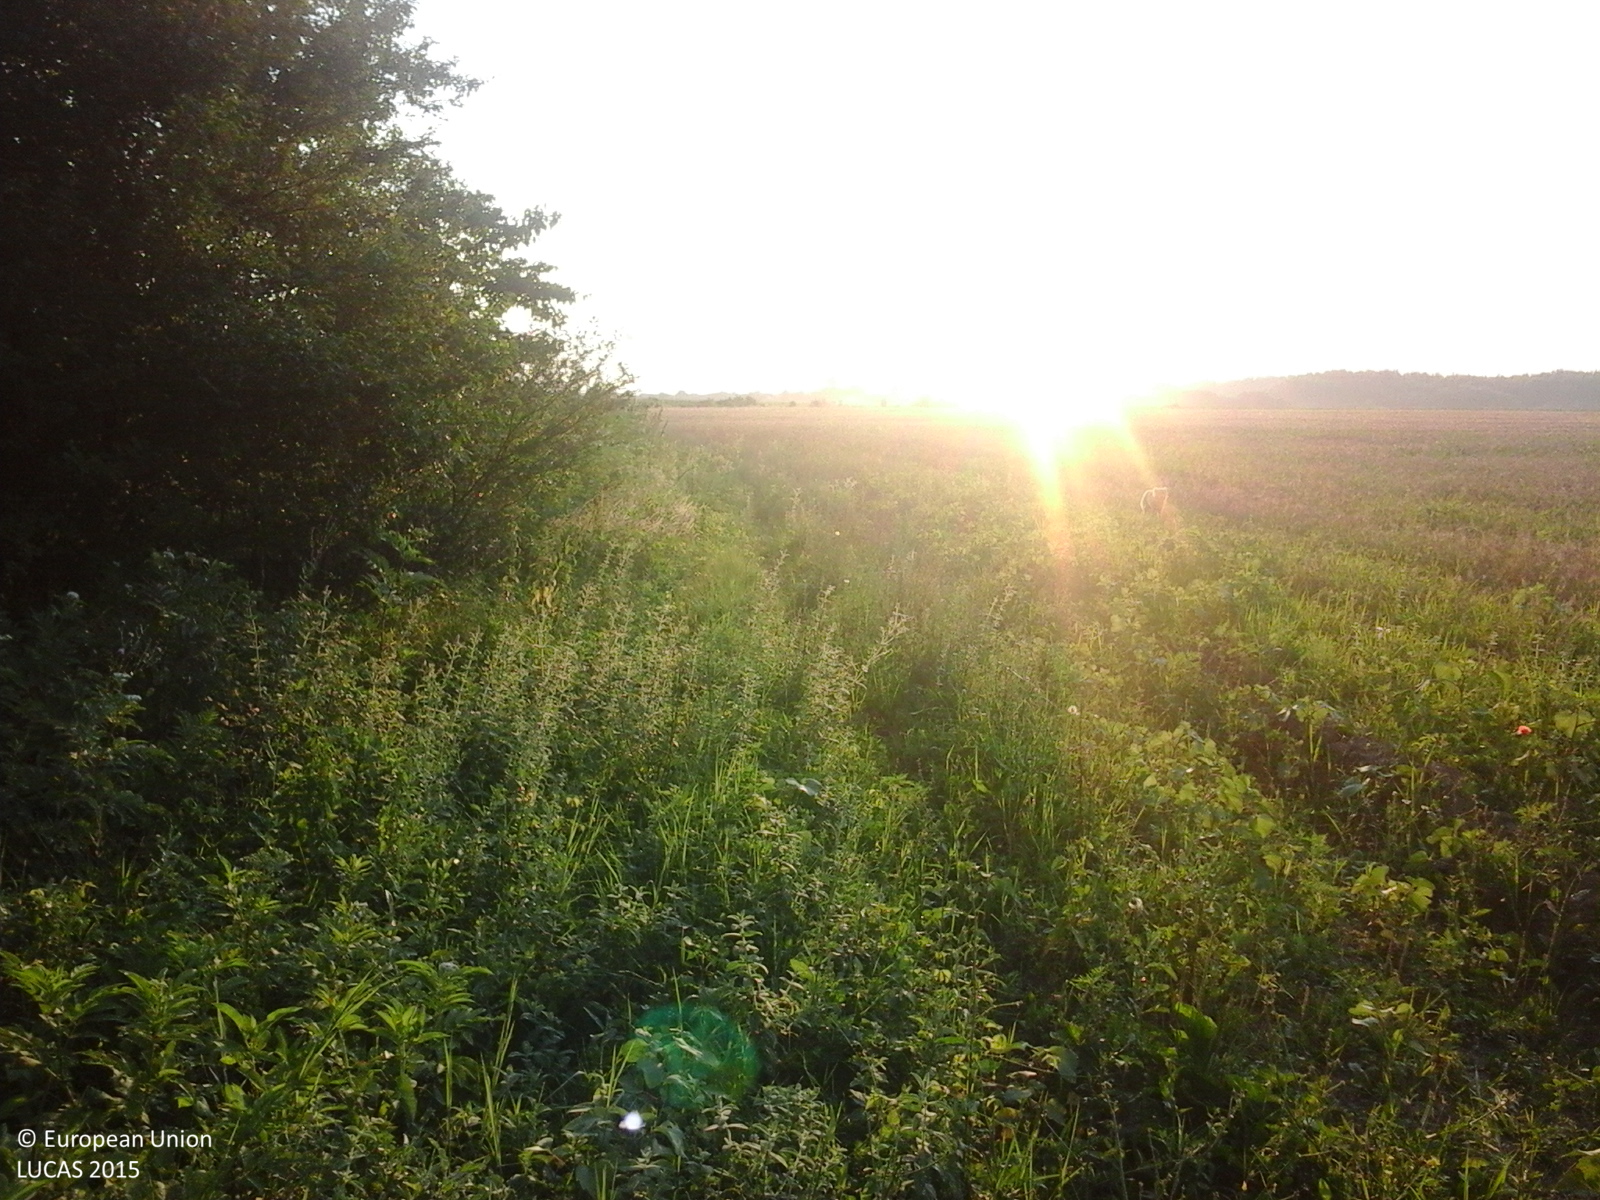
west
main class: Woodland
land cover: Broadleaved woodland
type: non-riverine alder, birch or aspen forest
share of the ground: > 75 %
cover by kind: broadleaved forest trees 100 %
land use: Forestry
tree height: > 5 m
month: July
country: RO
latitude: 44.7017
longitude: 25.6068
